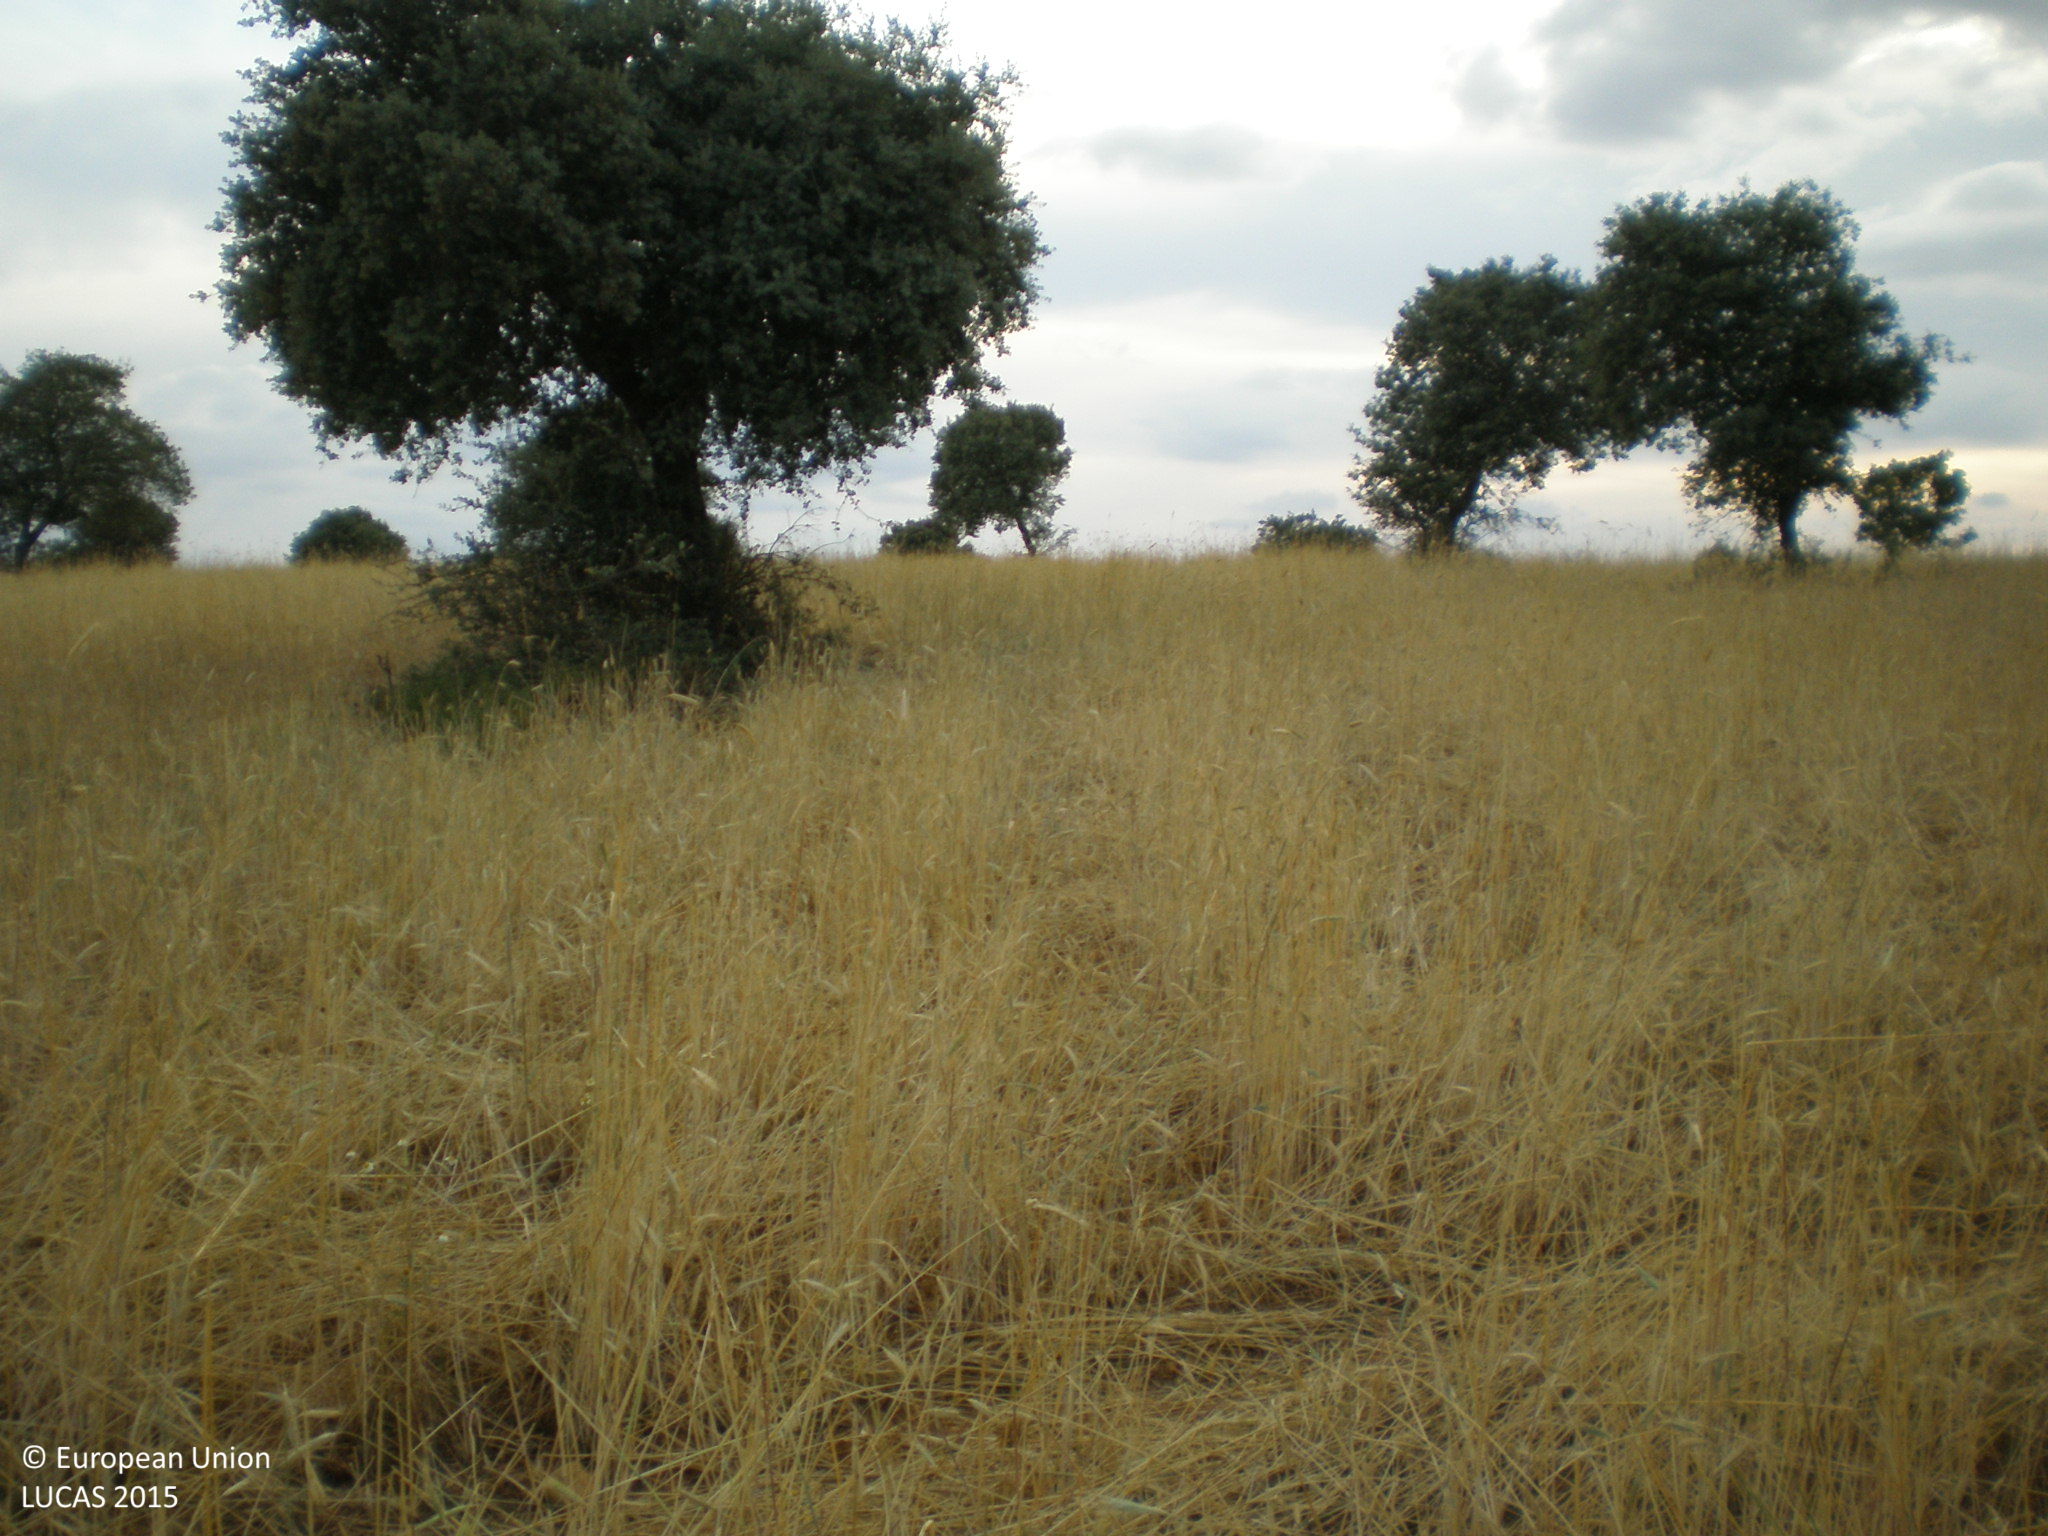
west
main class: Cropland
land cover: Rye
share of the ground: > 75 %
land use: Agriculture (excluding fallow land and kitchen gardens)
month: June
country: ES
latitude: 41.2221
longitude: -5.7935
